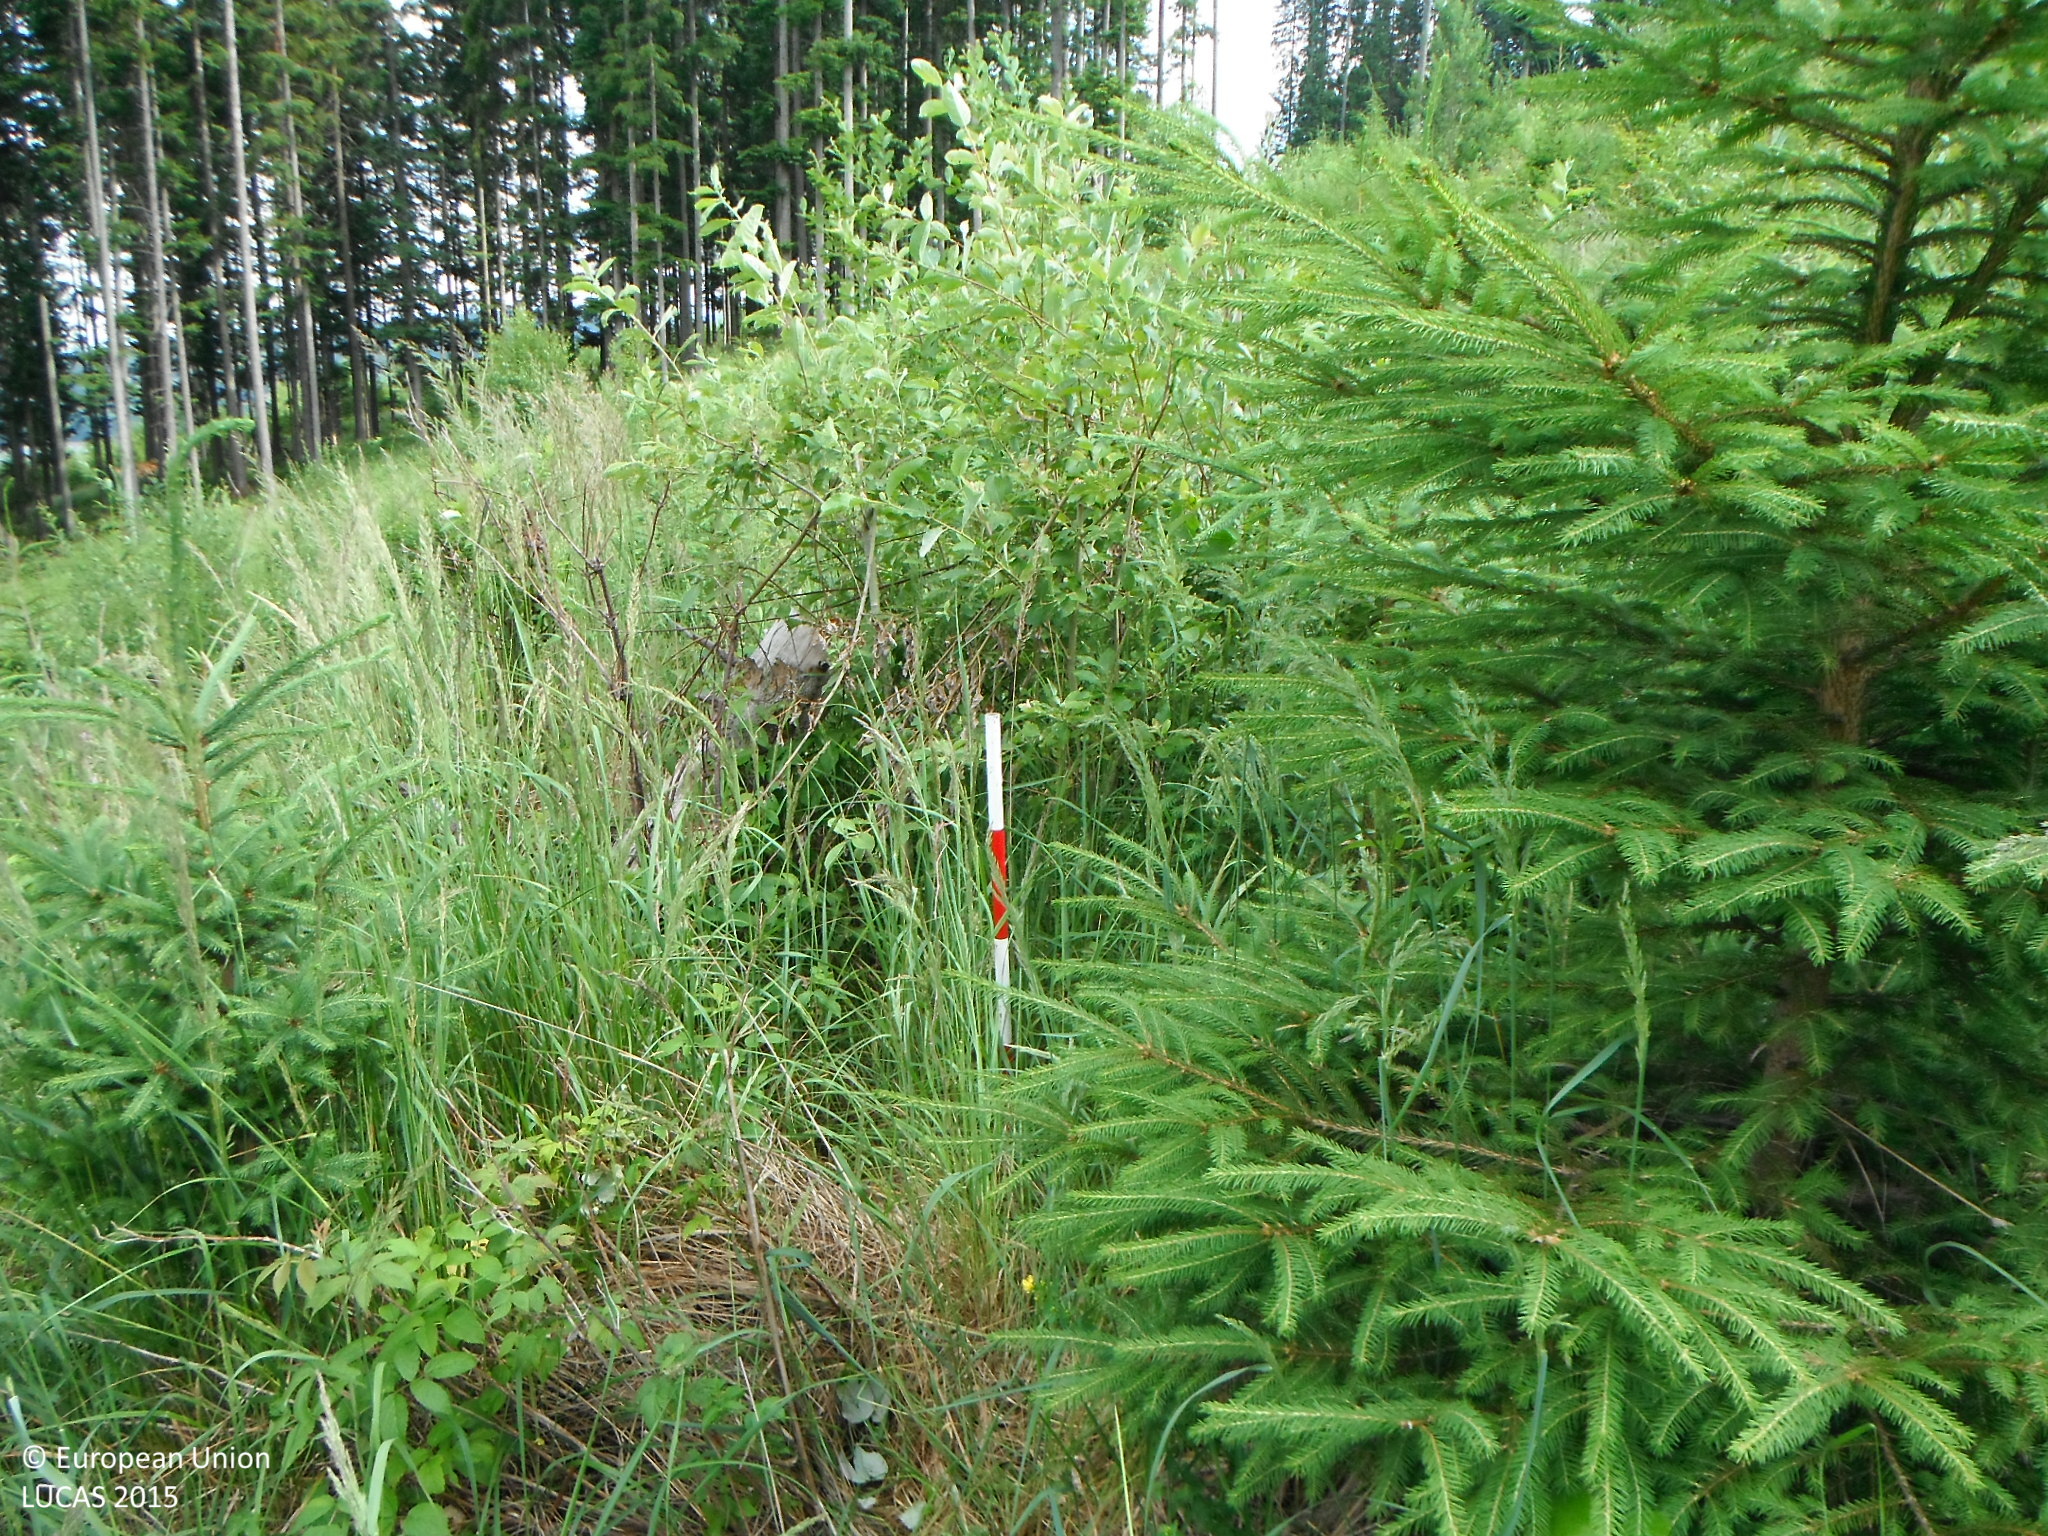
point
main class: Shrubland
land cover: Shrubland without tree cover
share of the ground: > 75 %
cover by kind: shrubs 80 %, herbaceous plants 20 %
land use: Forestry
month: July
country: SK
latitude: 49.3868
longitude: 19.5185
